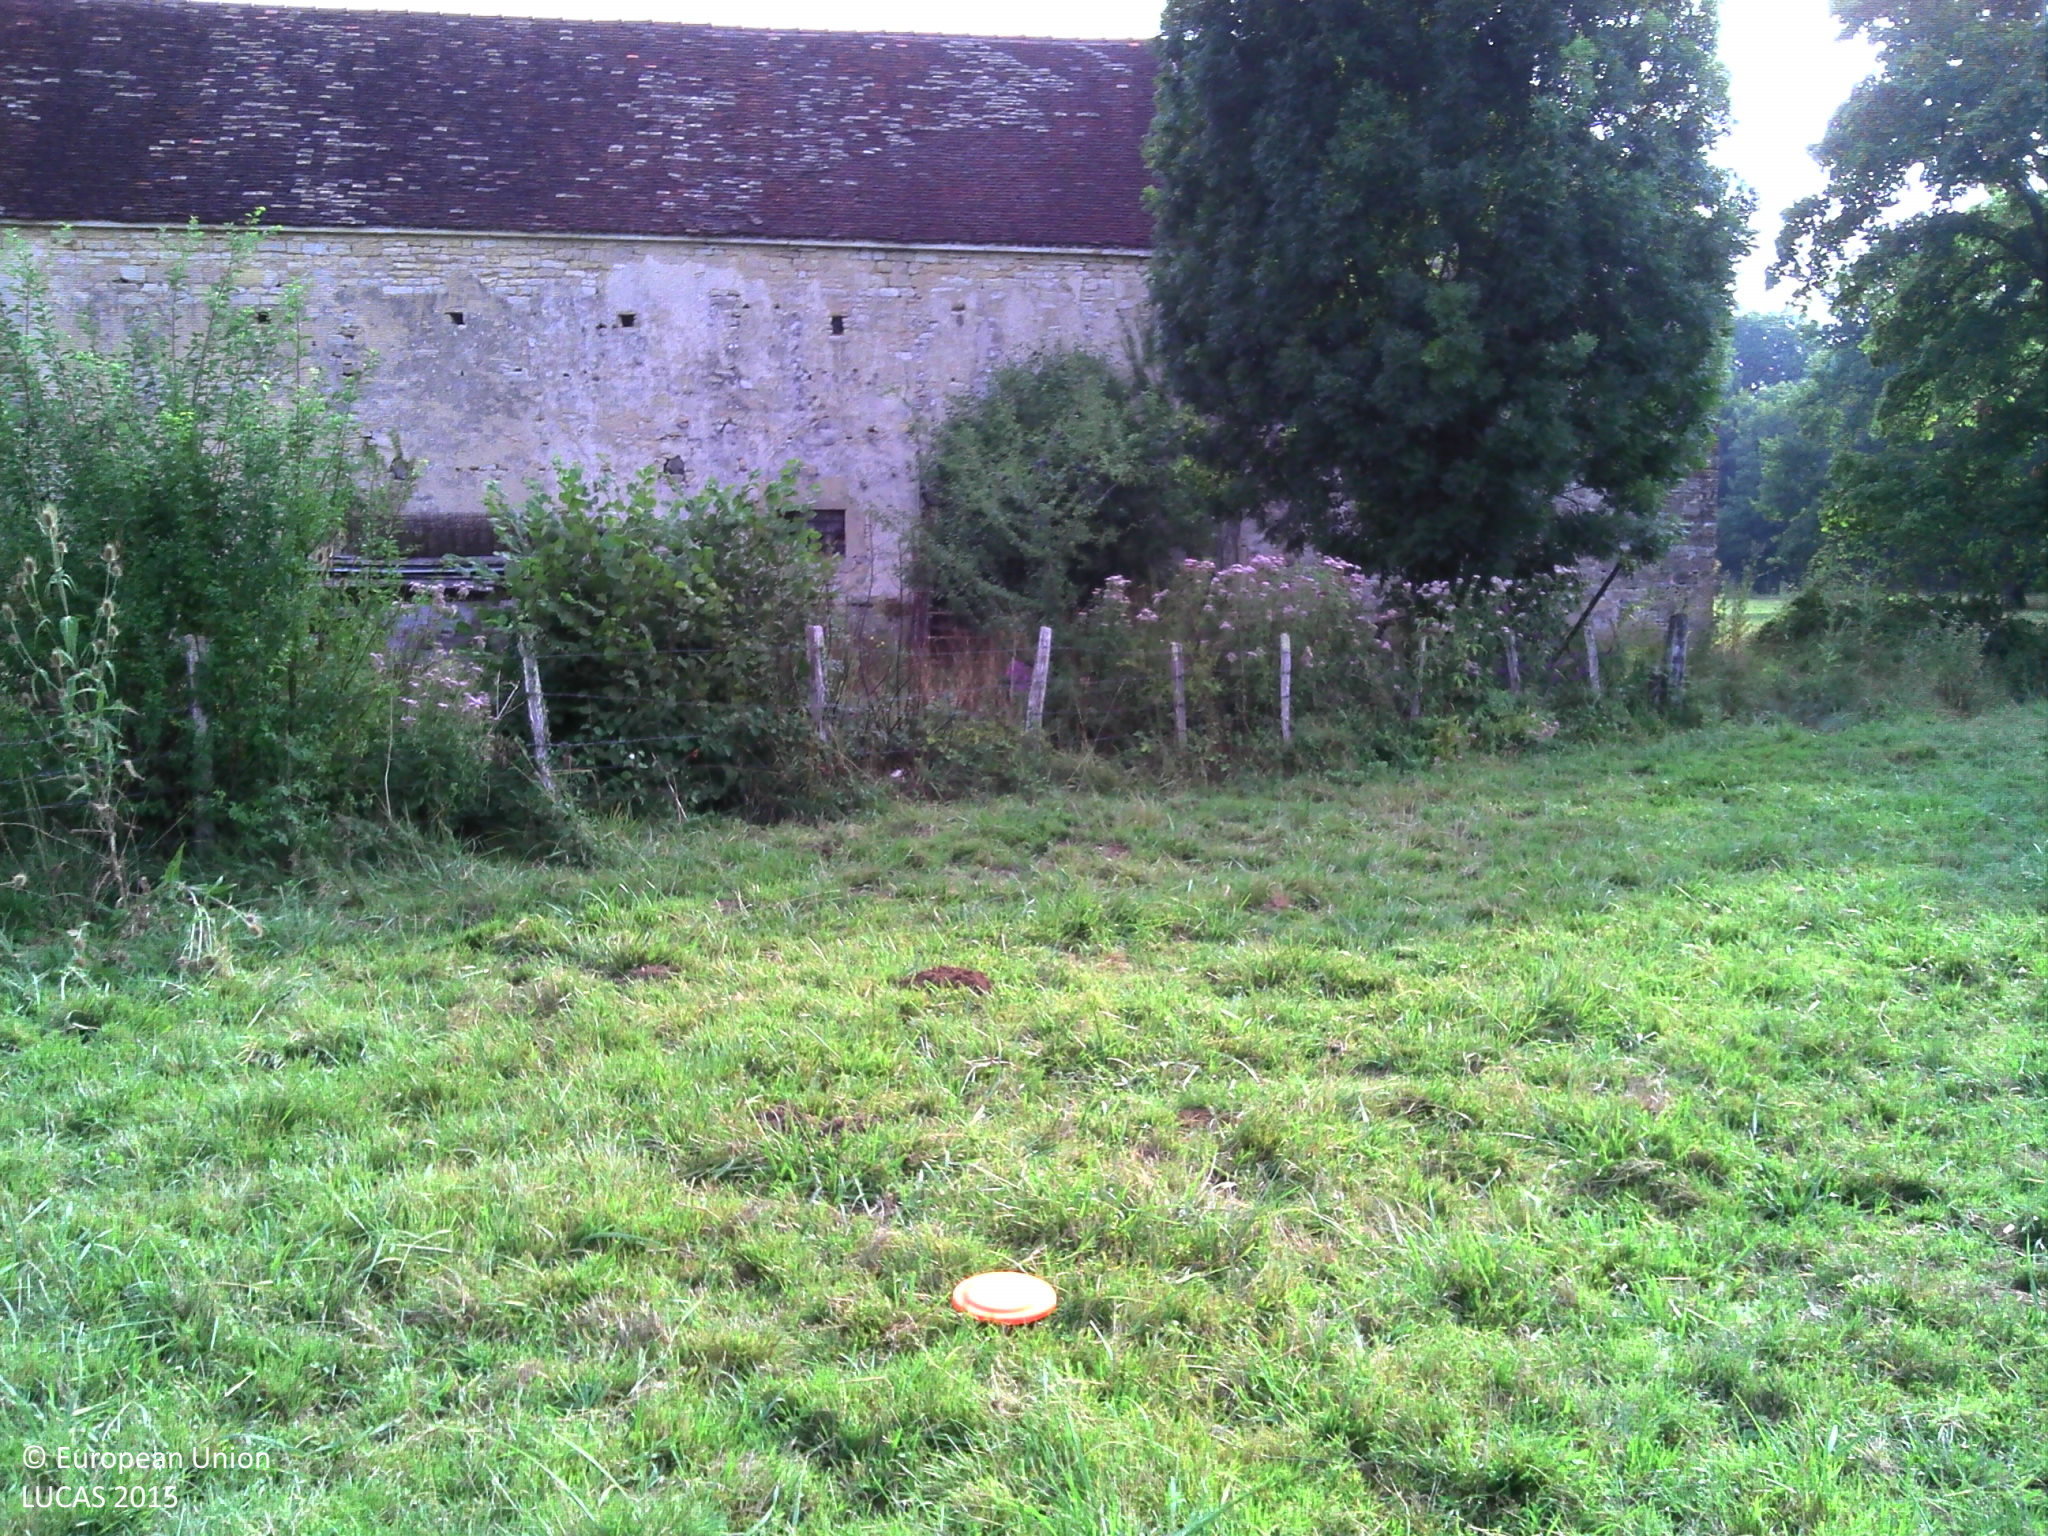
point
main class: Grassland
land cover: Grassland without tree/shrub cover
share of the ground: > 75 %
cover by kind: herbaceous plants 100 %
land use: Agriculture (excluding fallow land and kitchen gardens)
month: August
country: FR
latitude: 47.8426
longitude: 4.3190
